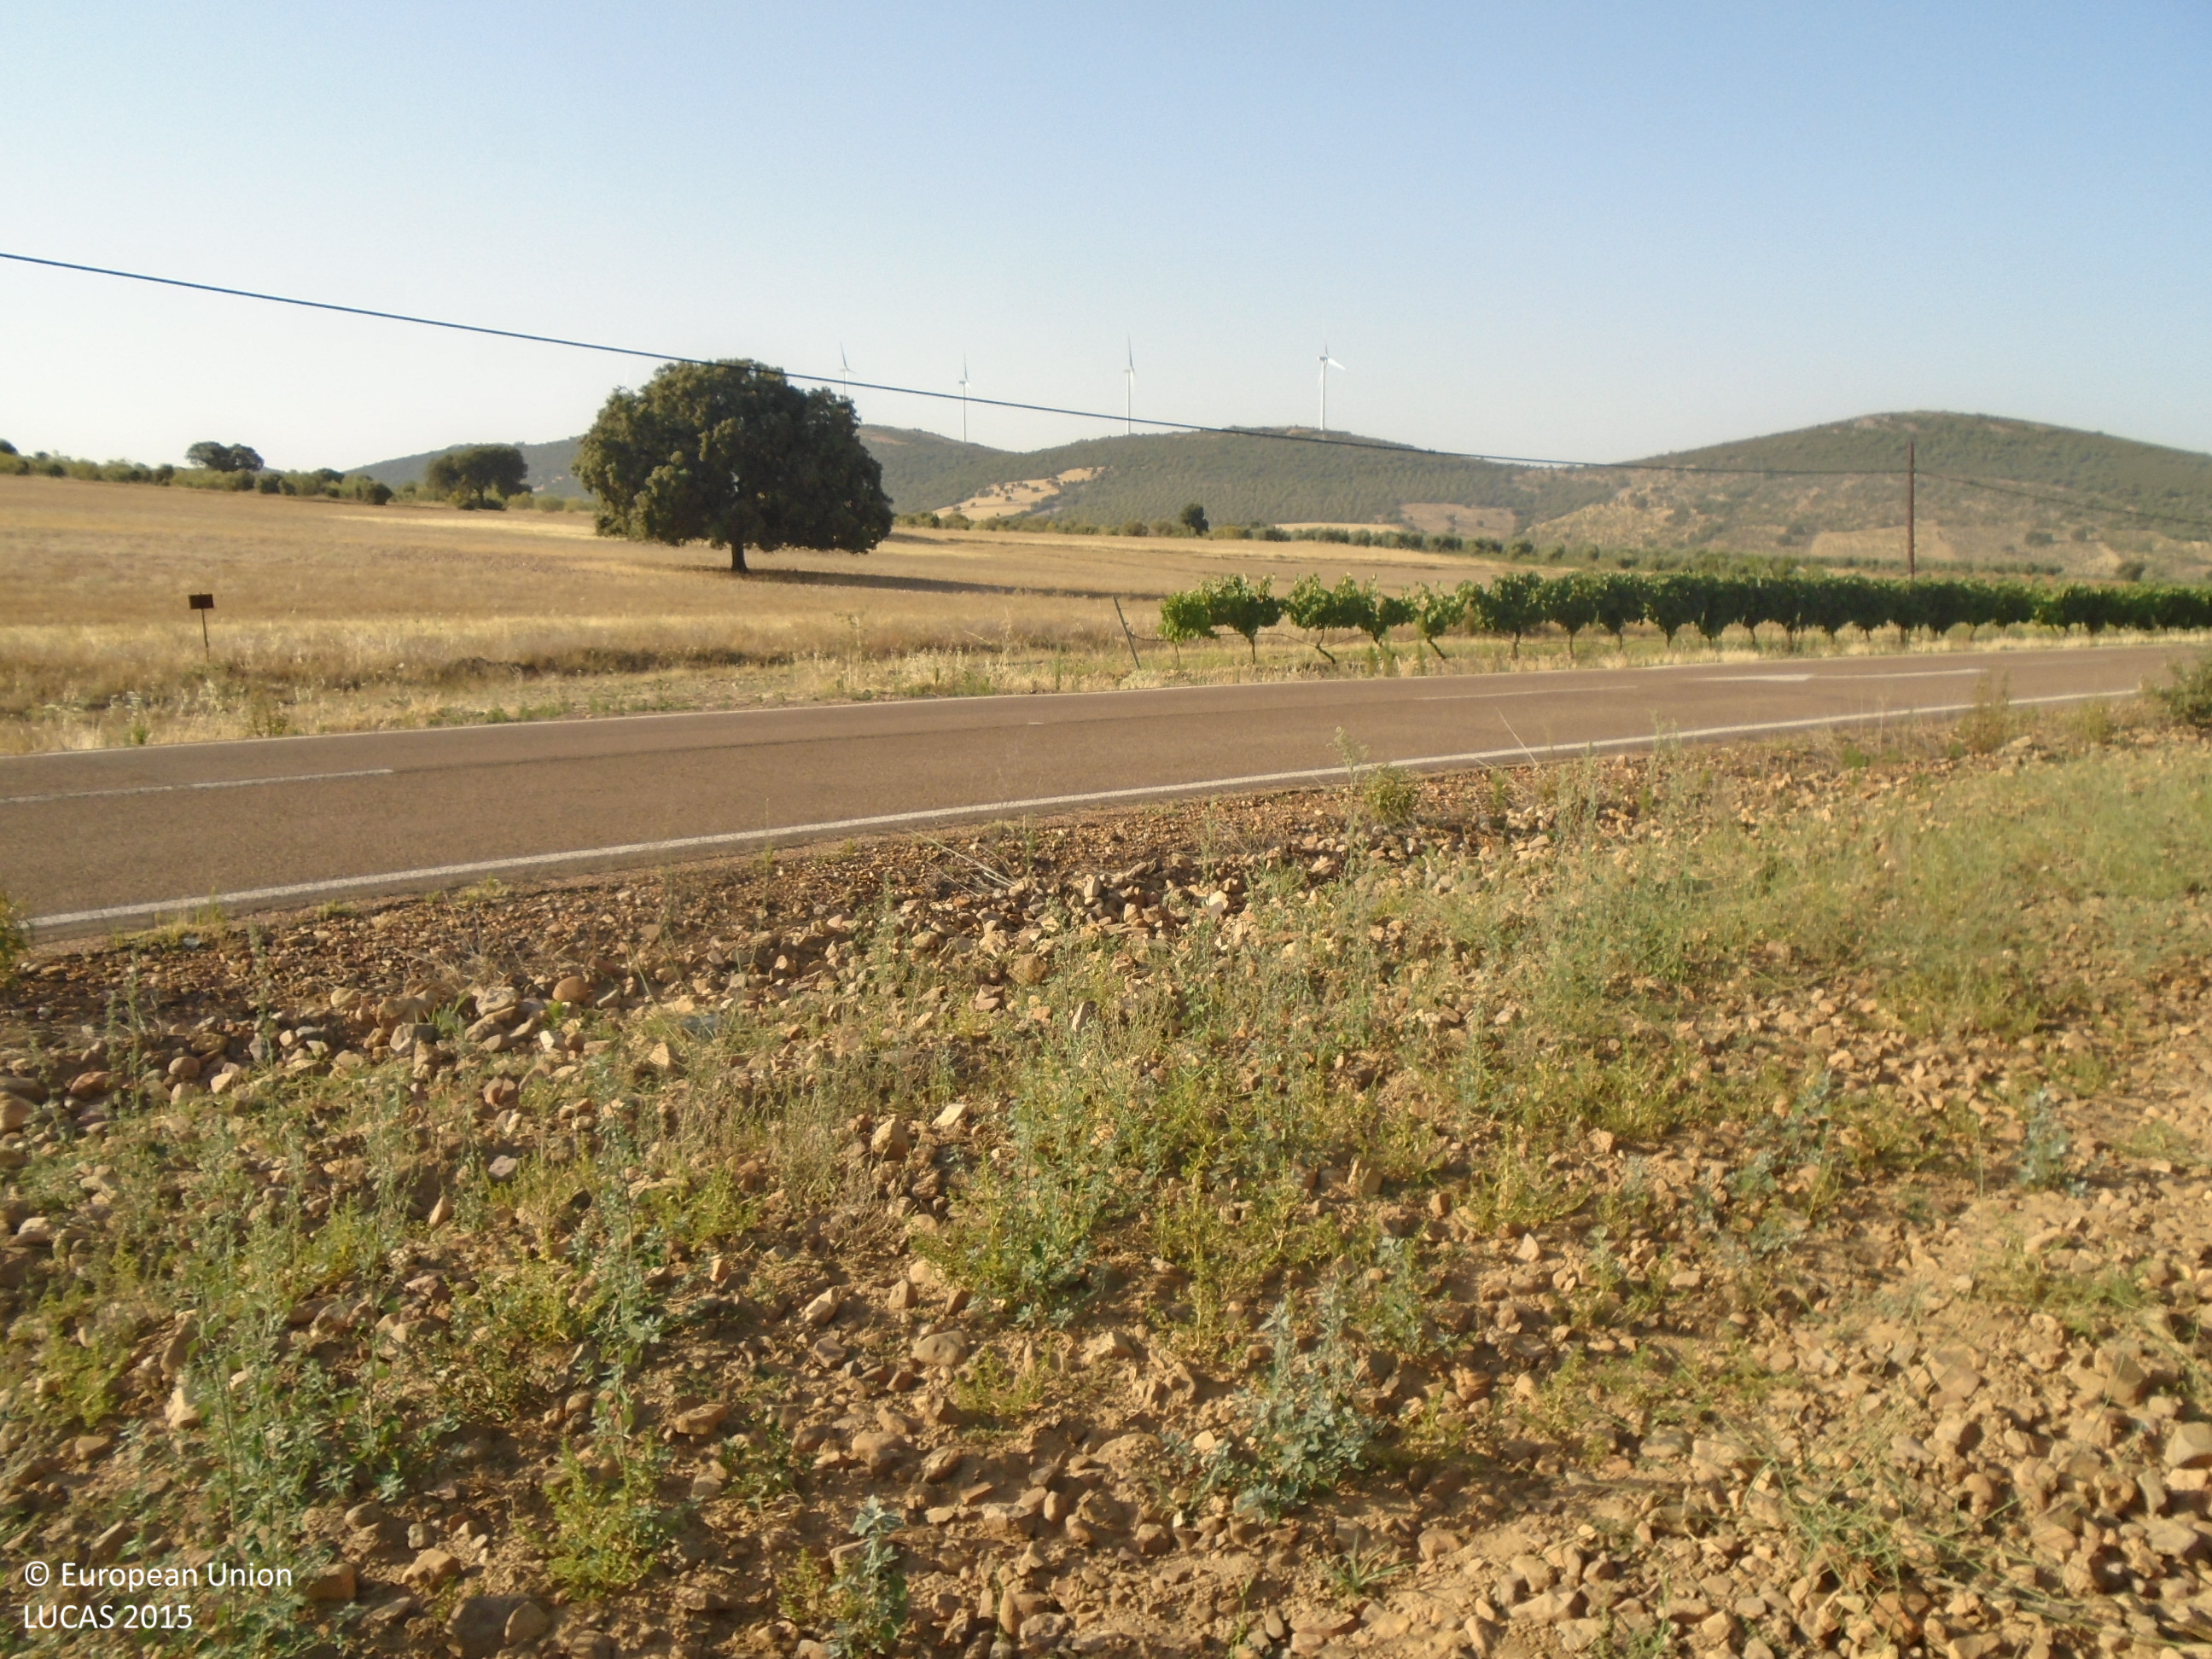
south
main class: Cropland
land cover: Vineyards
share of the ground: 10 - 25 %
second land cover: Other bare soil
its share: > 75 %
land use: Agriculture (excluding fallow land and kitchen gardens)
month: July
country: ES
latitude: 39.2783
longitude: -4.1117
